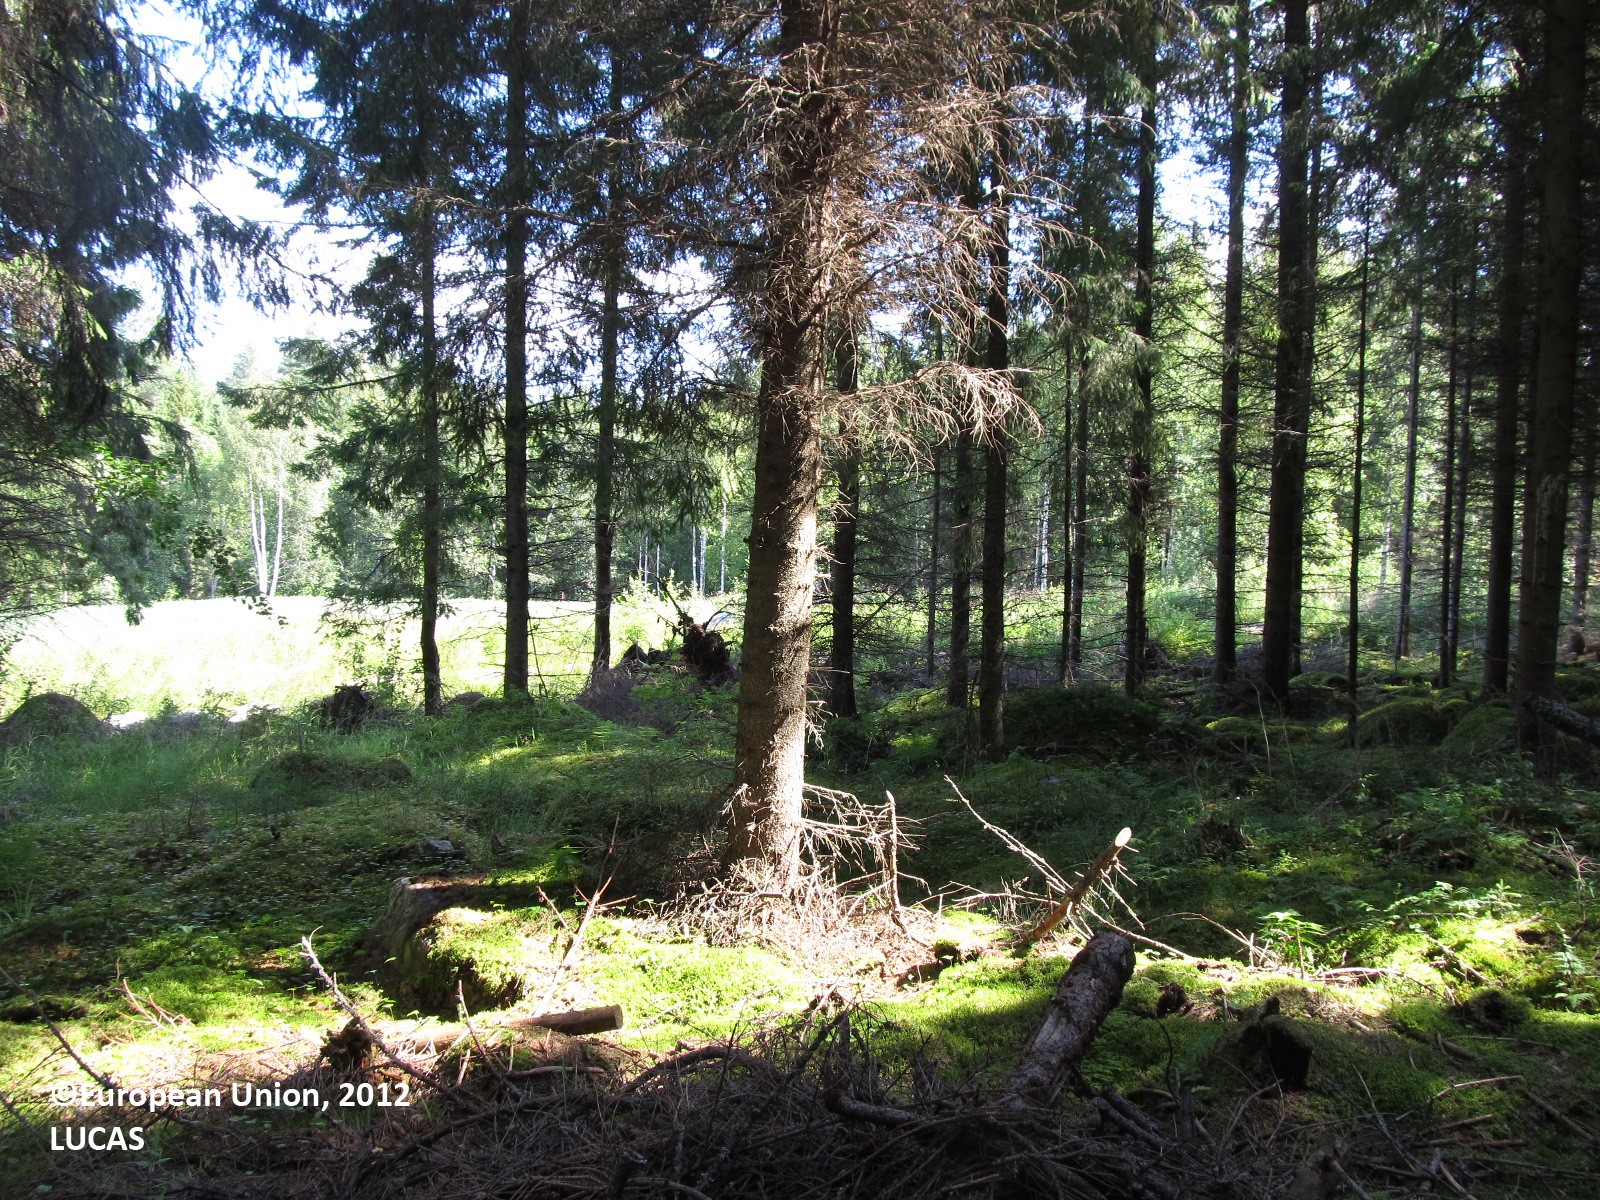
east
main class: Woodland
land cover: Spruce dominated coniferous woodland
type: boreal forest
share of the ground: 25 - 50 %
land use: Forestry
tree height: > 5 m
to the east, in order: Spruce dominated coniferous woodland; Ditches and canals; Spruce dominated coniferous woodland; Ditches and canals; Grass margins; Paved roads, cycling and walking lanes; Grass margins; Ditches and canals; Broadleaved woodland; Spruce dominated coniferous woodland; Ditches and canals; Spruce dominated coniferous woodland
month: July
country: FI
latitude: 61.9828
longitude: 28.5474
